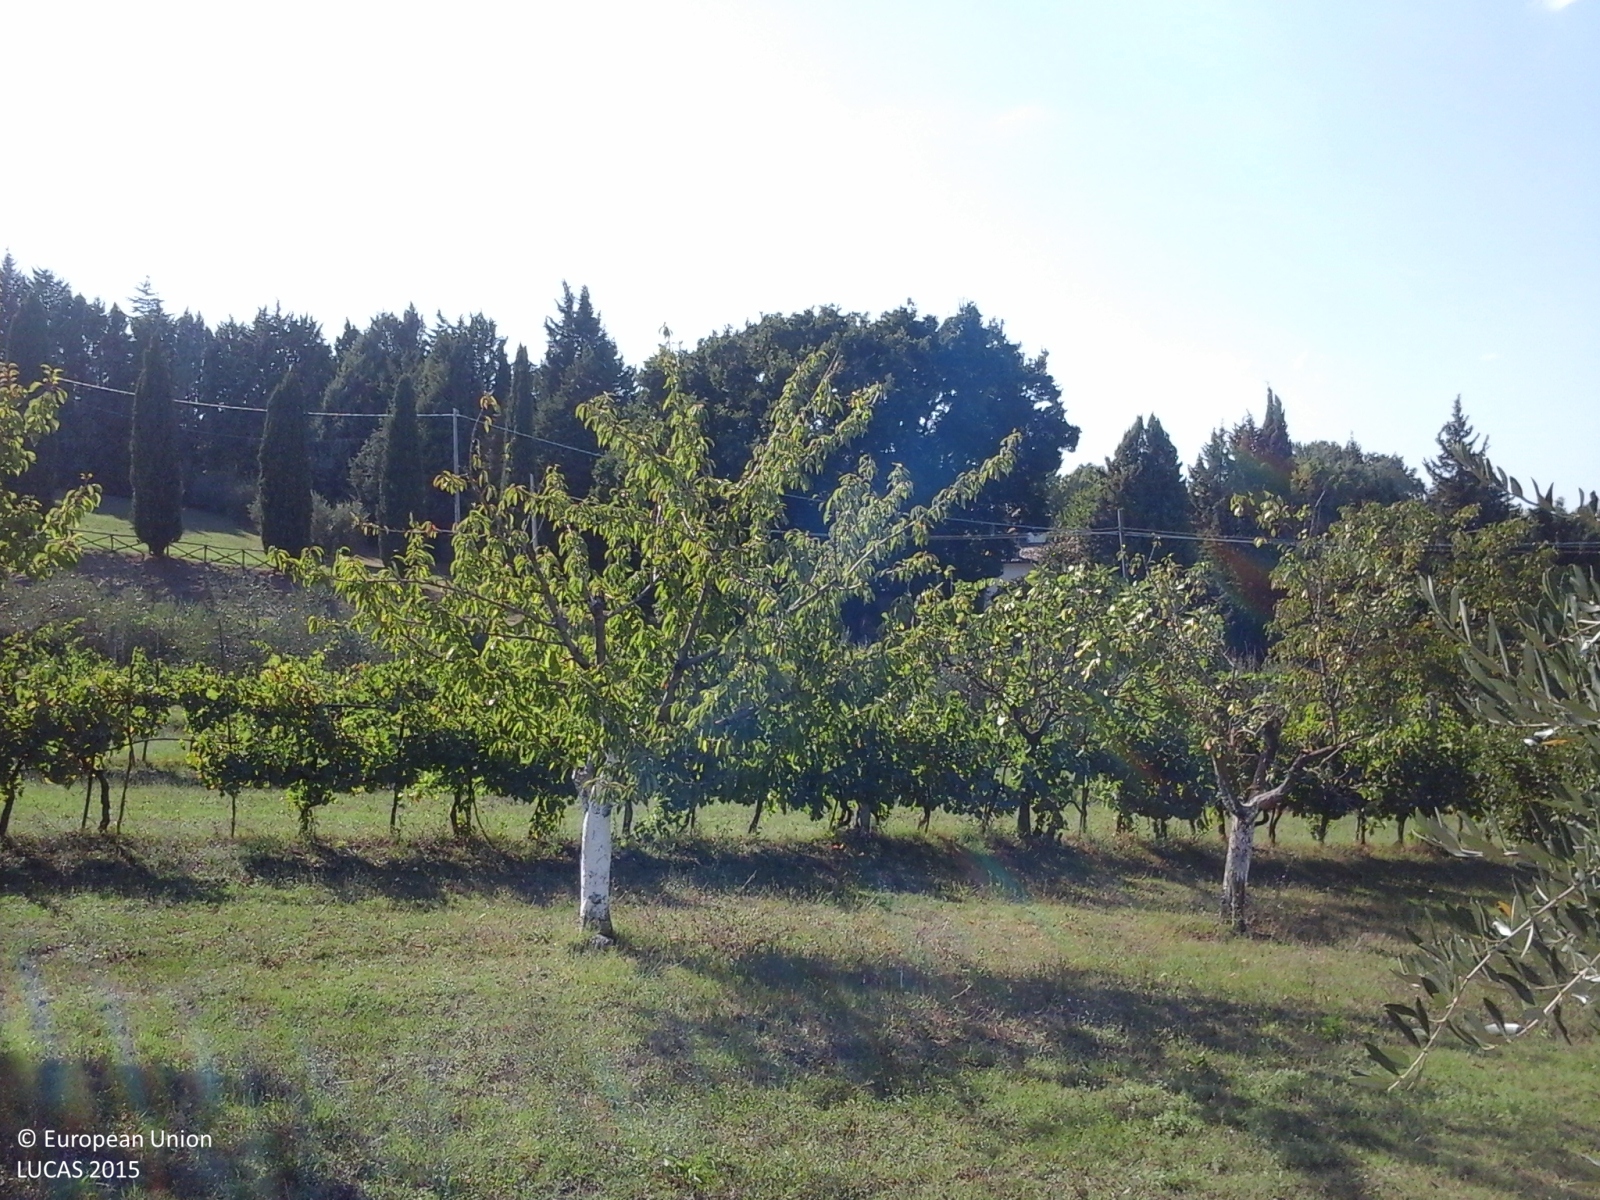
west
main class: Cropland
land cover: Olive groves
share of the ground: 10 - 25 %
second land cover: Grassland without tree/shrub cover
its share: > 75 %
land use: Agriculture (excluding fallow land and kitchen gardens)
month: August
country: IT
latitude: 42.8615
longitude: 12.3550
